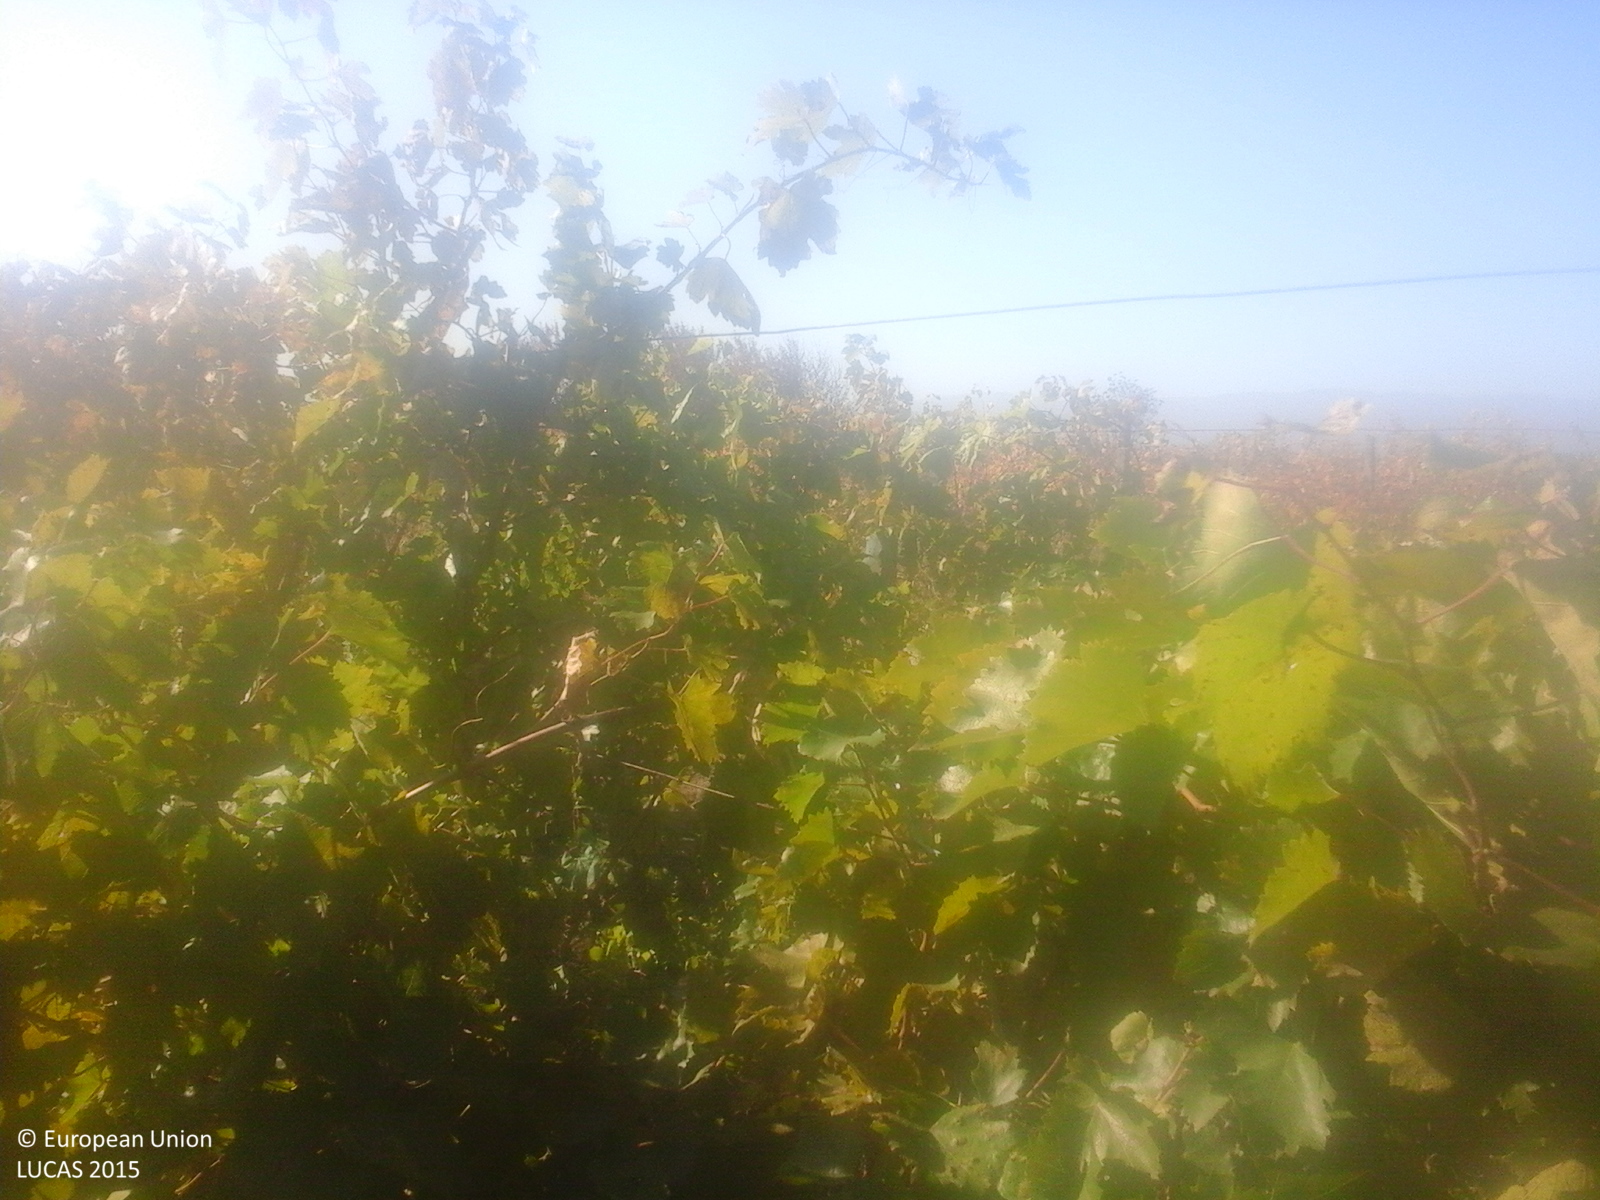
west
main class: Cropland
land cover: Vineyards
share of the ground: > 75 %
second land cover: Spontaneously vegetated surfaces
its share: 50 - 75 %
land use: Agriculture (excluding fallow land and kitchen gardens)
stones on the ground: < 10 %
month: October
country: RO
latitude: 45.8435
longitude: 27.1031
